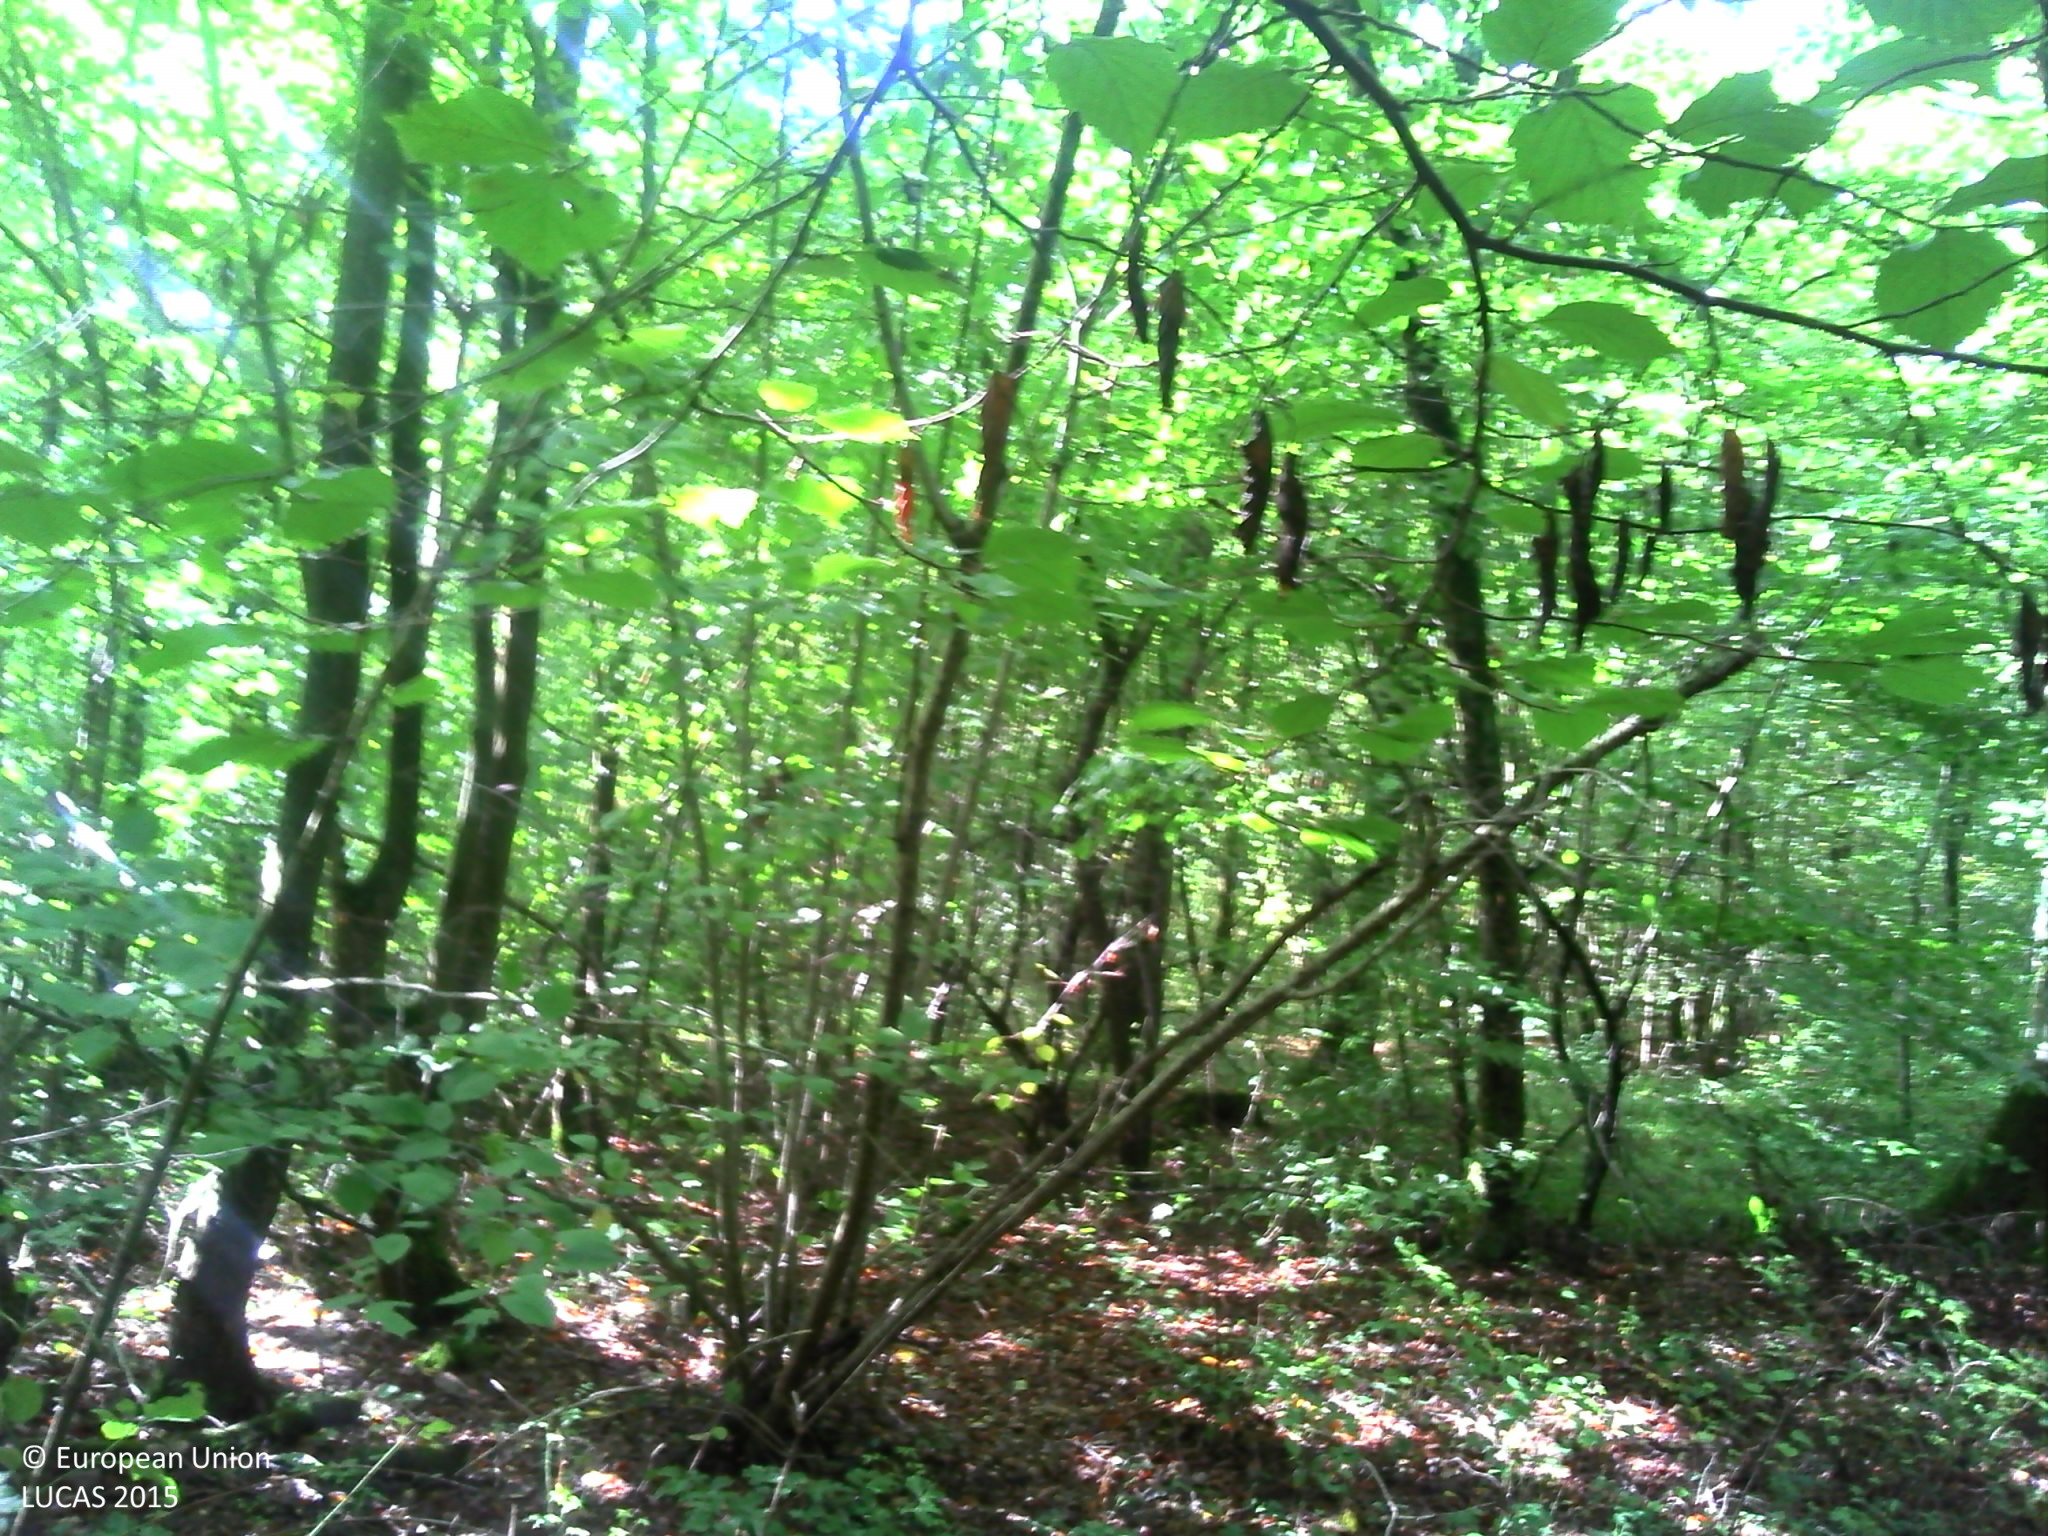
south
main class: Woodland
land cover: Broadleaved woodland
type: mesophytic deciduous forest
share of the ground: > 75 %
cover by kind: broadleaved forest trees 90 %, herbaceous plants 5 %, consolidated bare surface 5 %
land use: Forestry
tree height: > 5 m
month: September
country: FR
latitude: 48.8349
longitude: 5.9807
